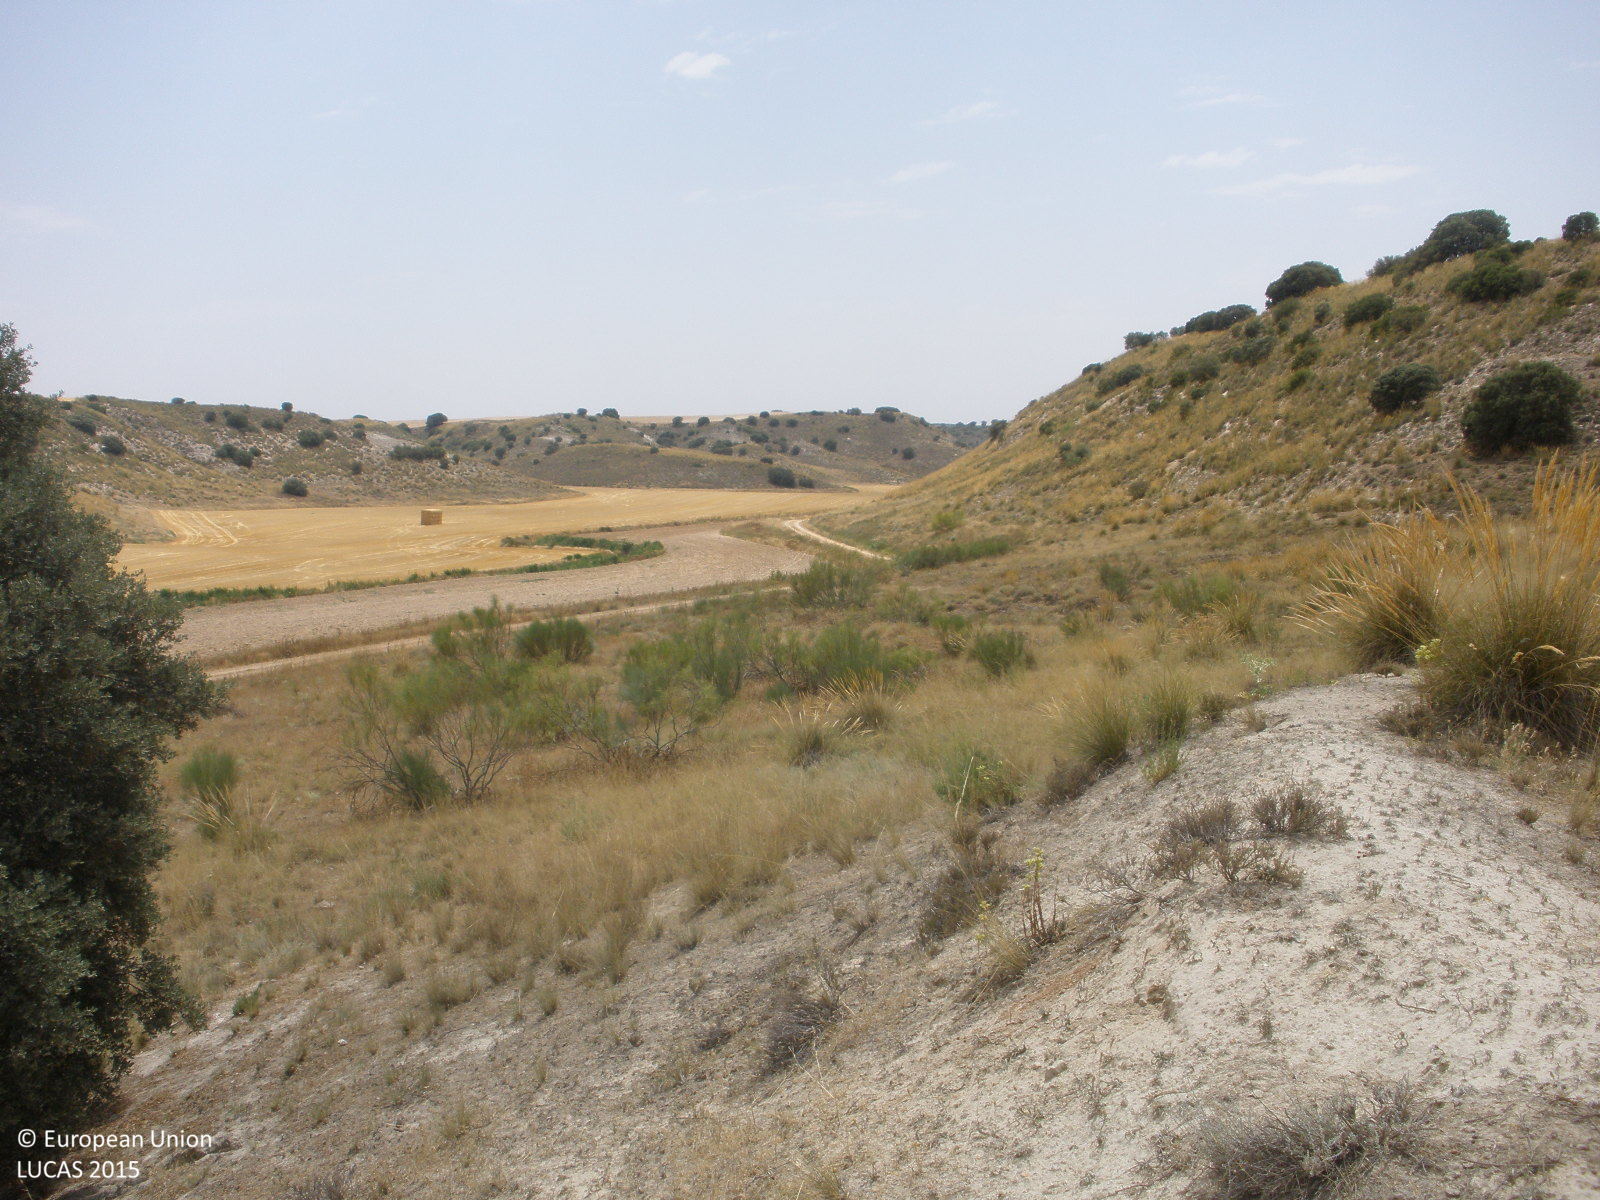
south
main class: Grassland
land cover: Grassland with sparse tree/shrub cover
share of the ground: 50 - 75 %
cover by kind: herbaceous plants 65 %, consolidated bare surface 25 %, broadleaved forest trees 5 %, shrubs 5 %
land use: Semi-natural and natural areas not in use
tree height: < 5 m
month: July
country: ES
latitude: 39.8613
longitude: -3.3639
